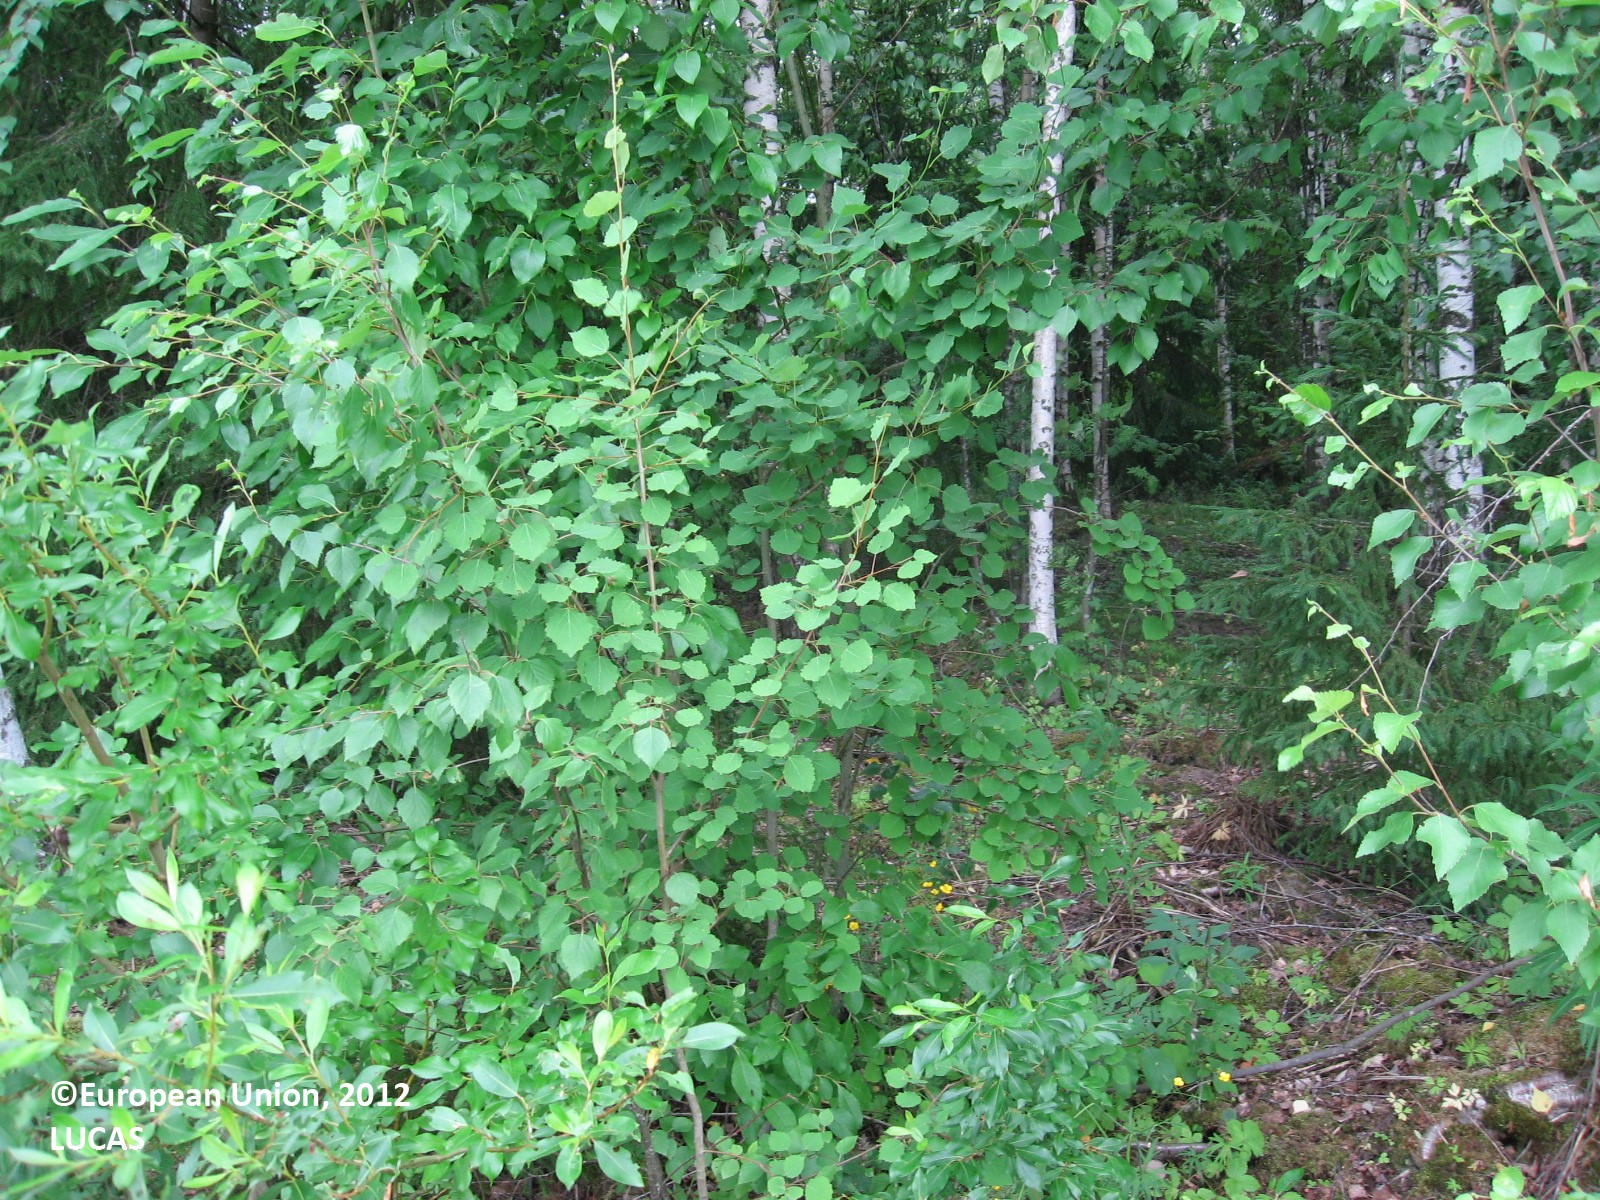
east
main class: Cropland
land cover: Oats
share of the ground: 50 - 75 %
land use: Agriculture (excluding fallow land and kitchen gardens)
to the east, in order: Oats; Broadleaved woodland; Ditches and canals; Broadleaved woodland; Artificial constructions in urban areas; Spruce dominated mixed woodland
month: July
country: FI
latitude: 60.8854
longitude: 25.6245
